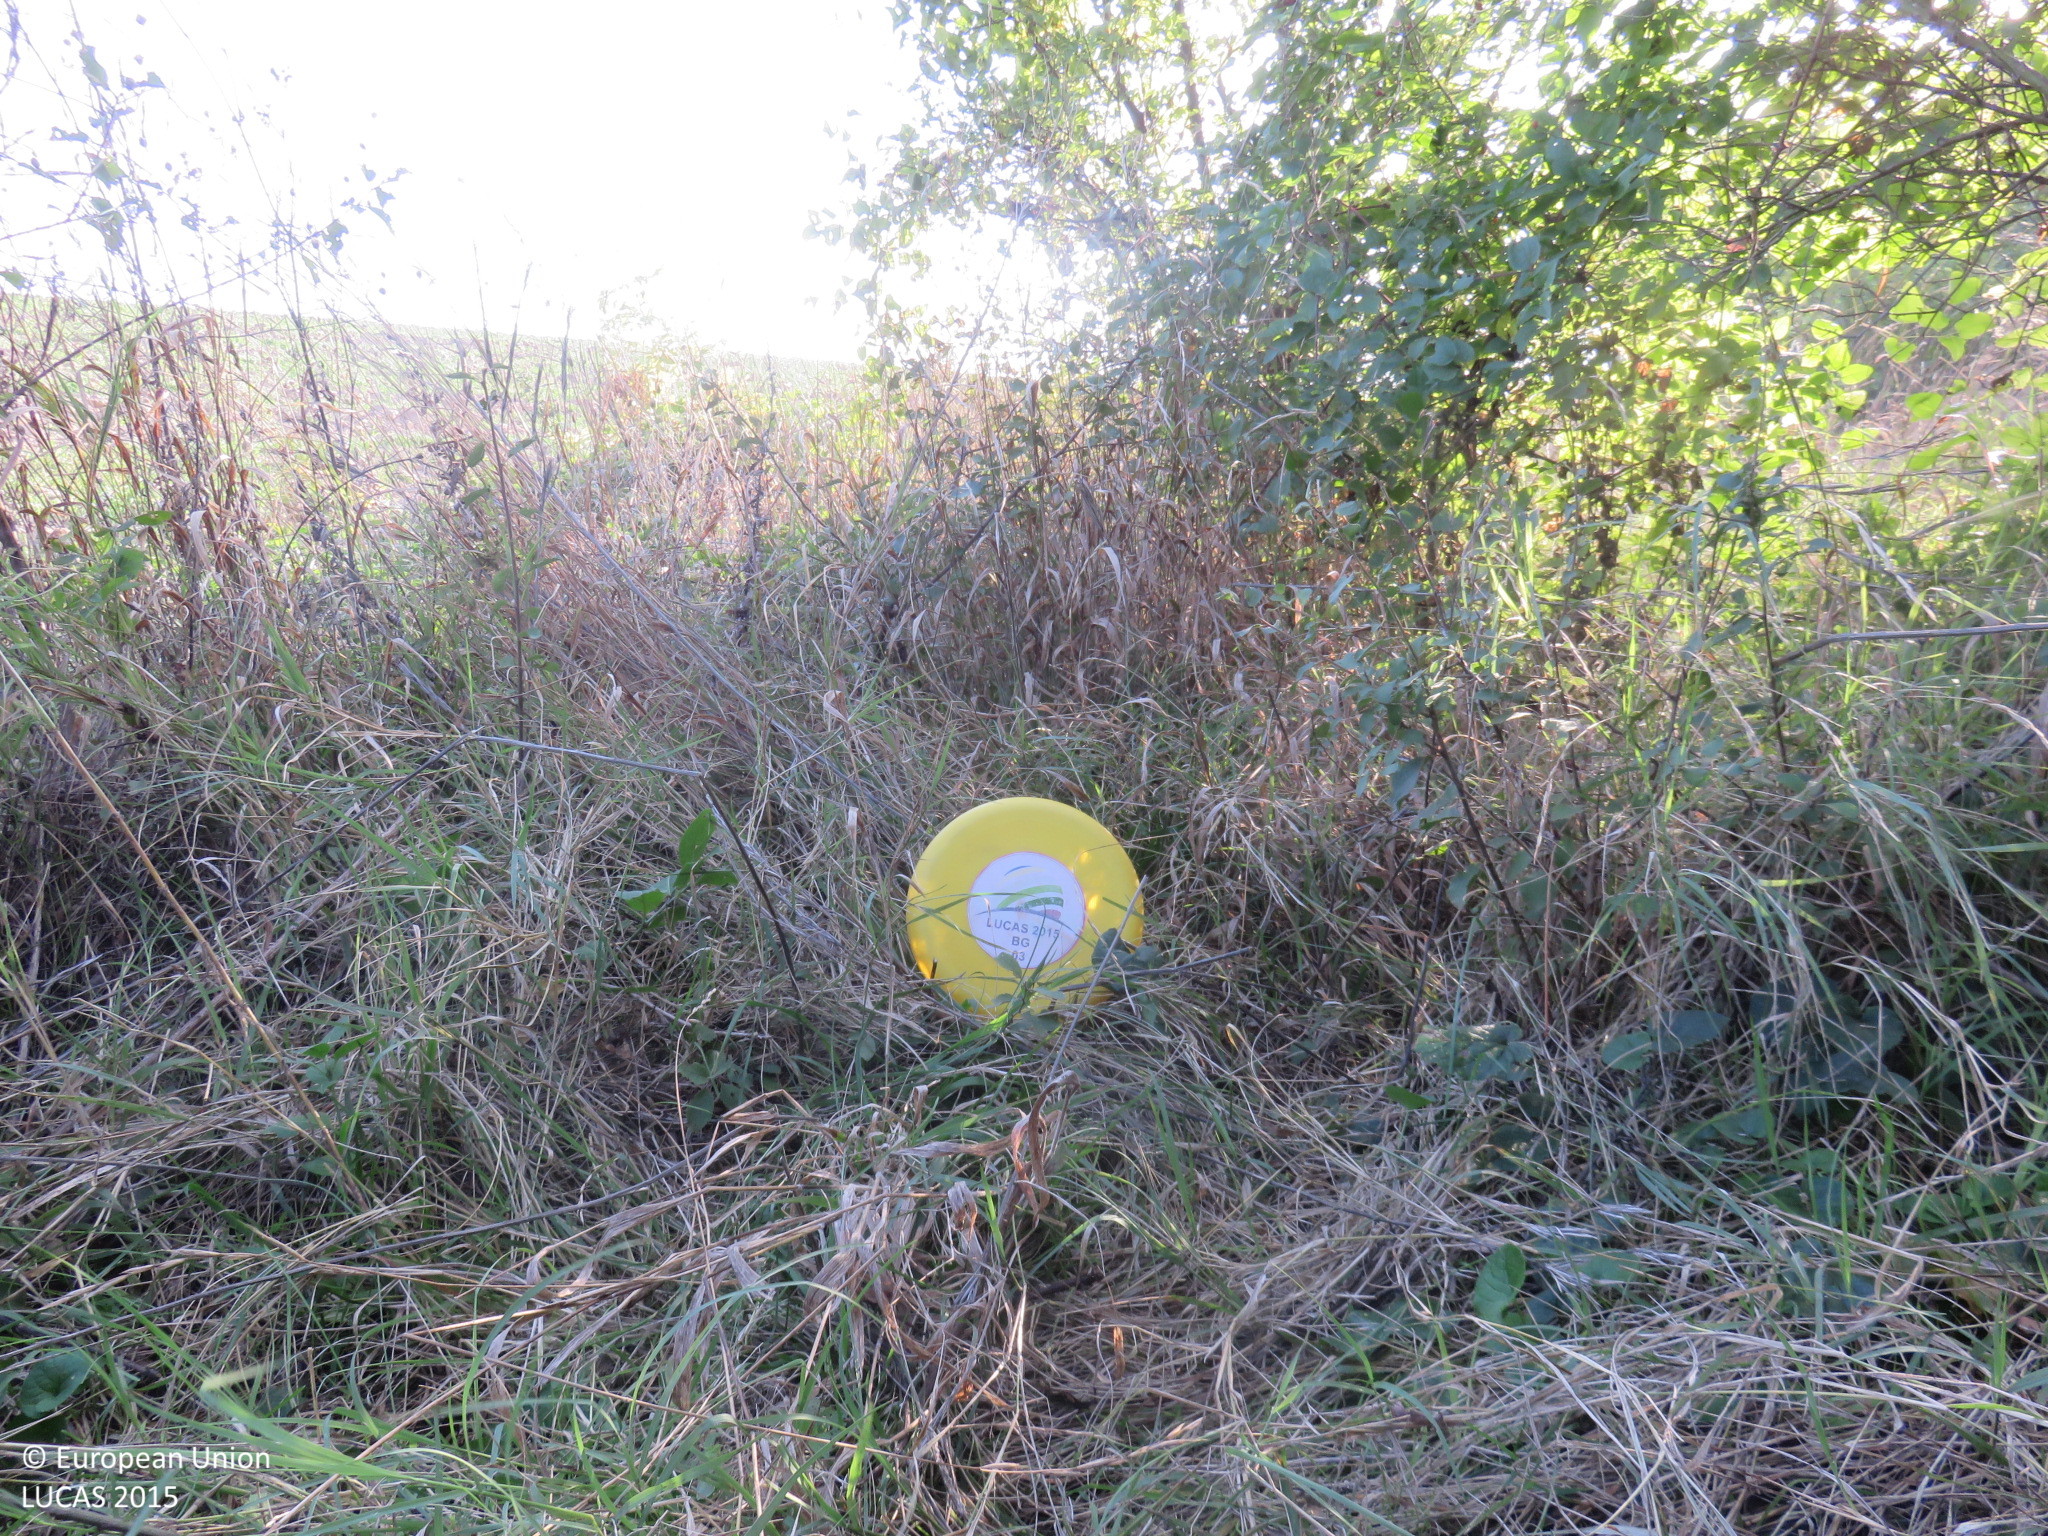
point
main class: Woodland
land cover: Broadleaved woodland
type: mesophytic deciduous forest
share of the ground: > 75 %
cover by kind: broadleaved forest trees 80 %, shrubs 15 %, herbaceous plants 5 %
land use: Forestry
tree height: < 5 m
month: September
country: BG
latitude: 43.5621
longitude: 25.0150
